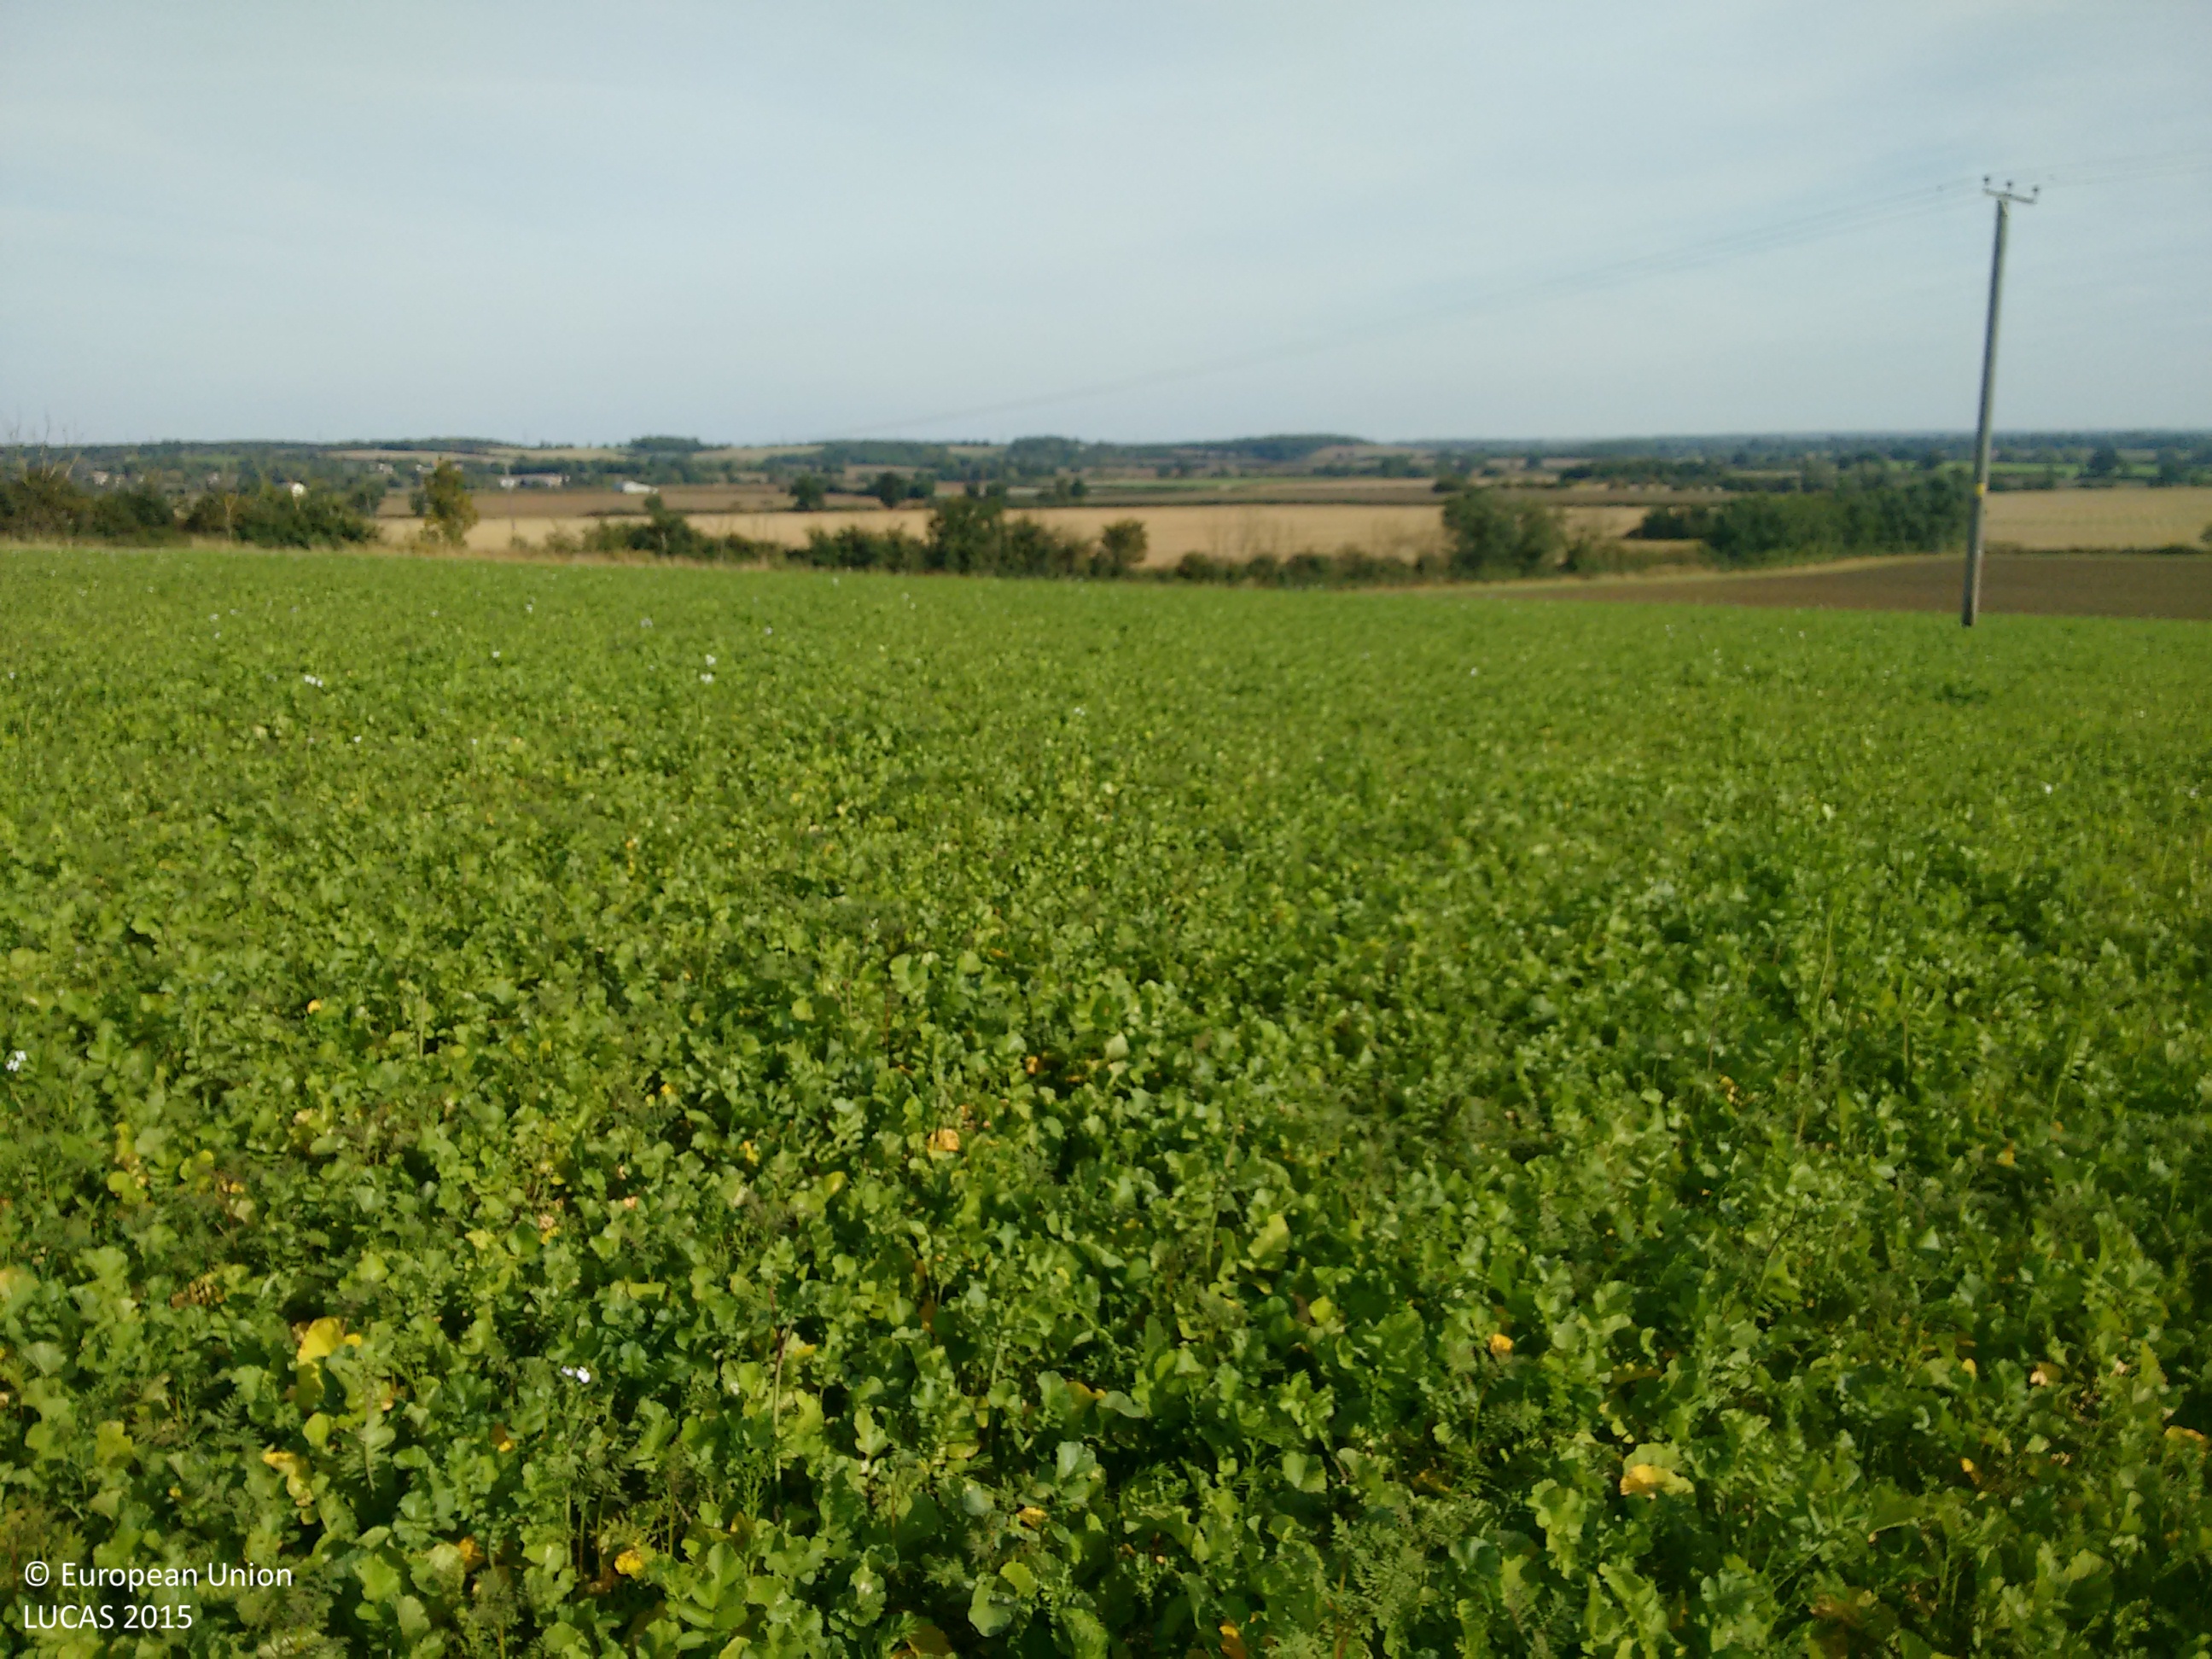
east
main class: Grassland
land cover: Spontaneously vegetated surfaces
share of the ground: > 75 %
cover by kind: herbaceous plants 100 %
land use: Fallow land
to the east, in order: Spontaneously vegetated surfaces; Electric lines; Grassland without tree/shrub cover; Abandoned hedges; Ditches and canals; Grass margins; Common wheat
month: September
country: GB
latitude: 52.2820
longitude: -0.4004
